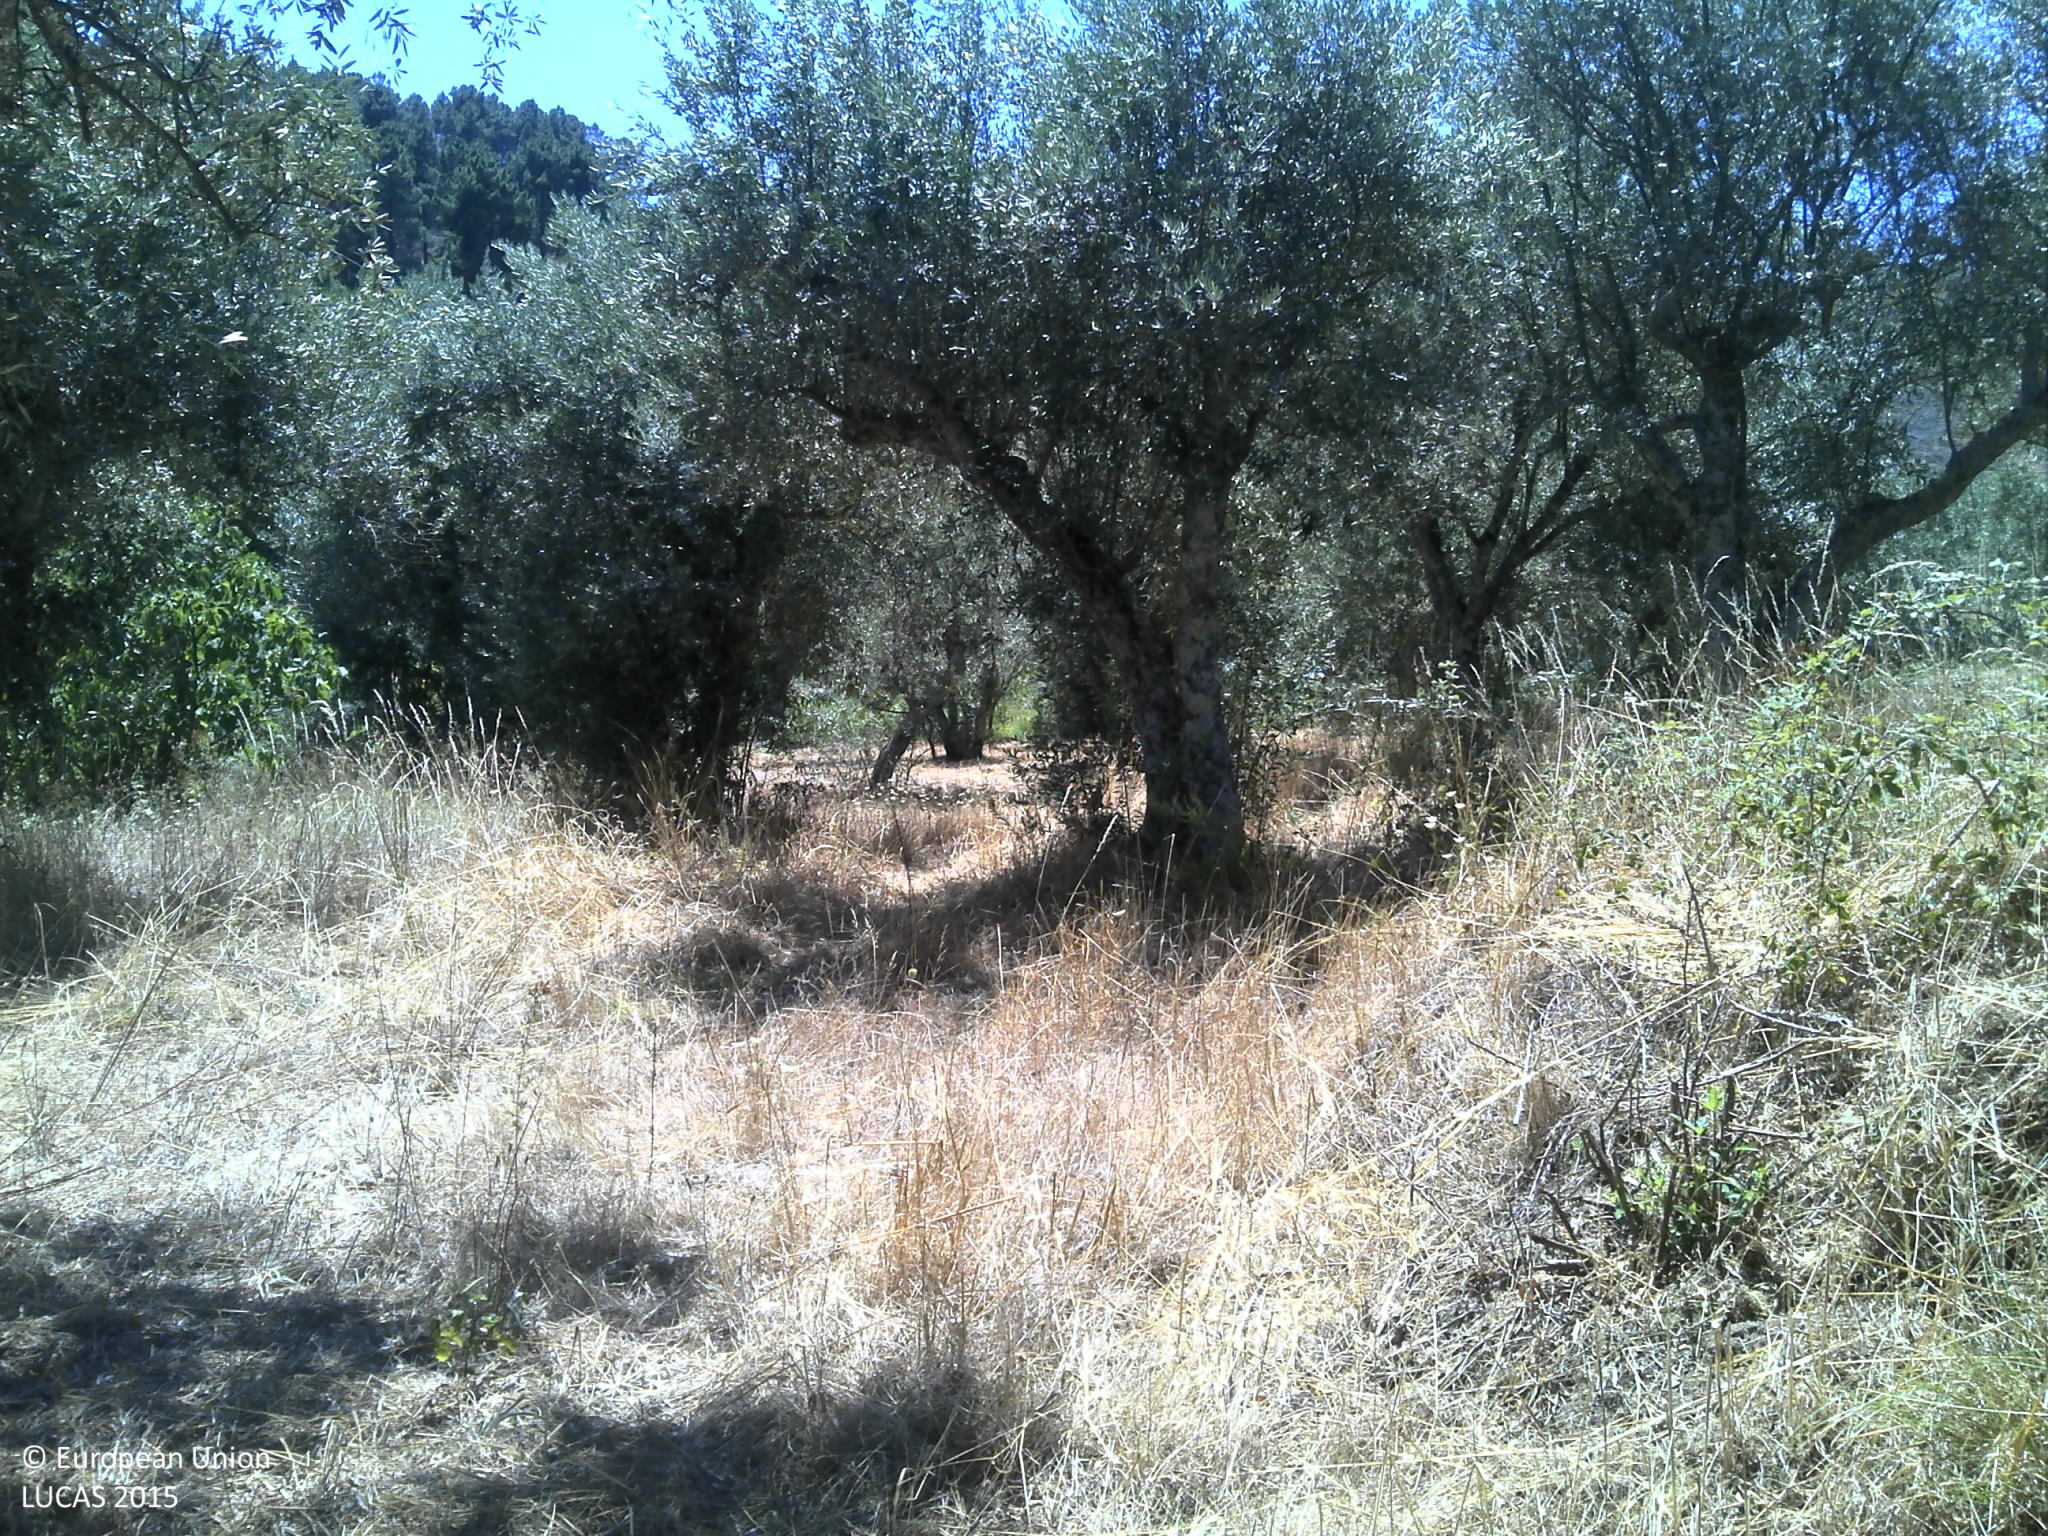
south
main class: Cropland
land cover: Olive groves
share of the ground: 50 - 75 %
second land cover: Grassland without tree/shrub cover
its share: 50 - 75 %
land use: Agriculture (excluding fallow land and kitchen gardens)
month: August
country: PT
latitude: 40.5770
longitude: -7.3197
